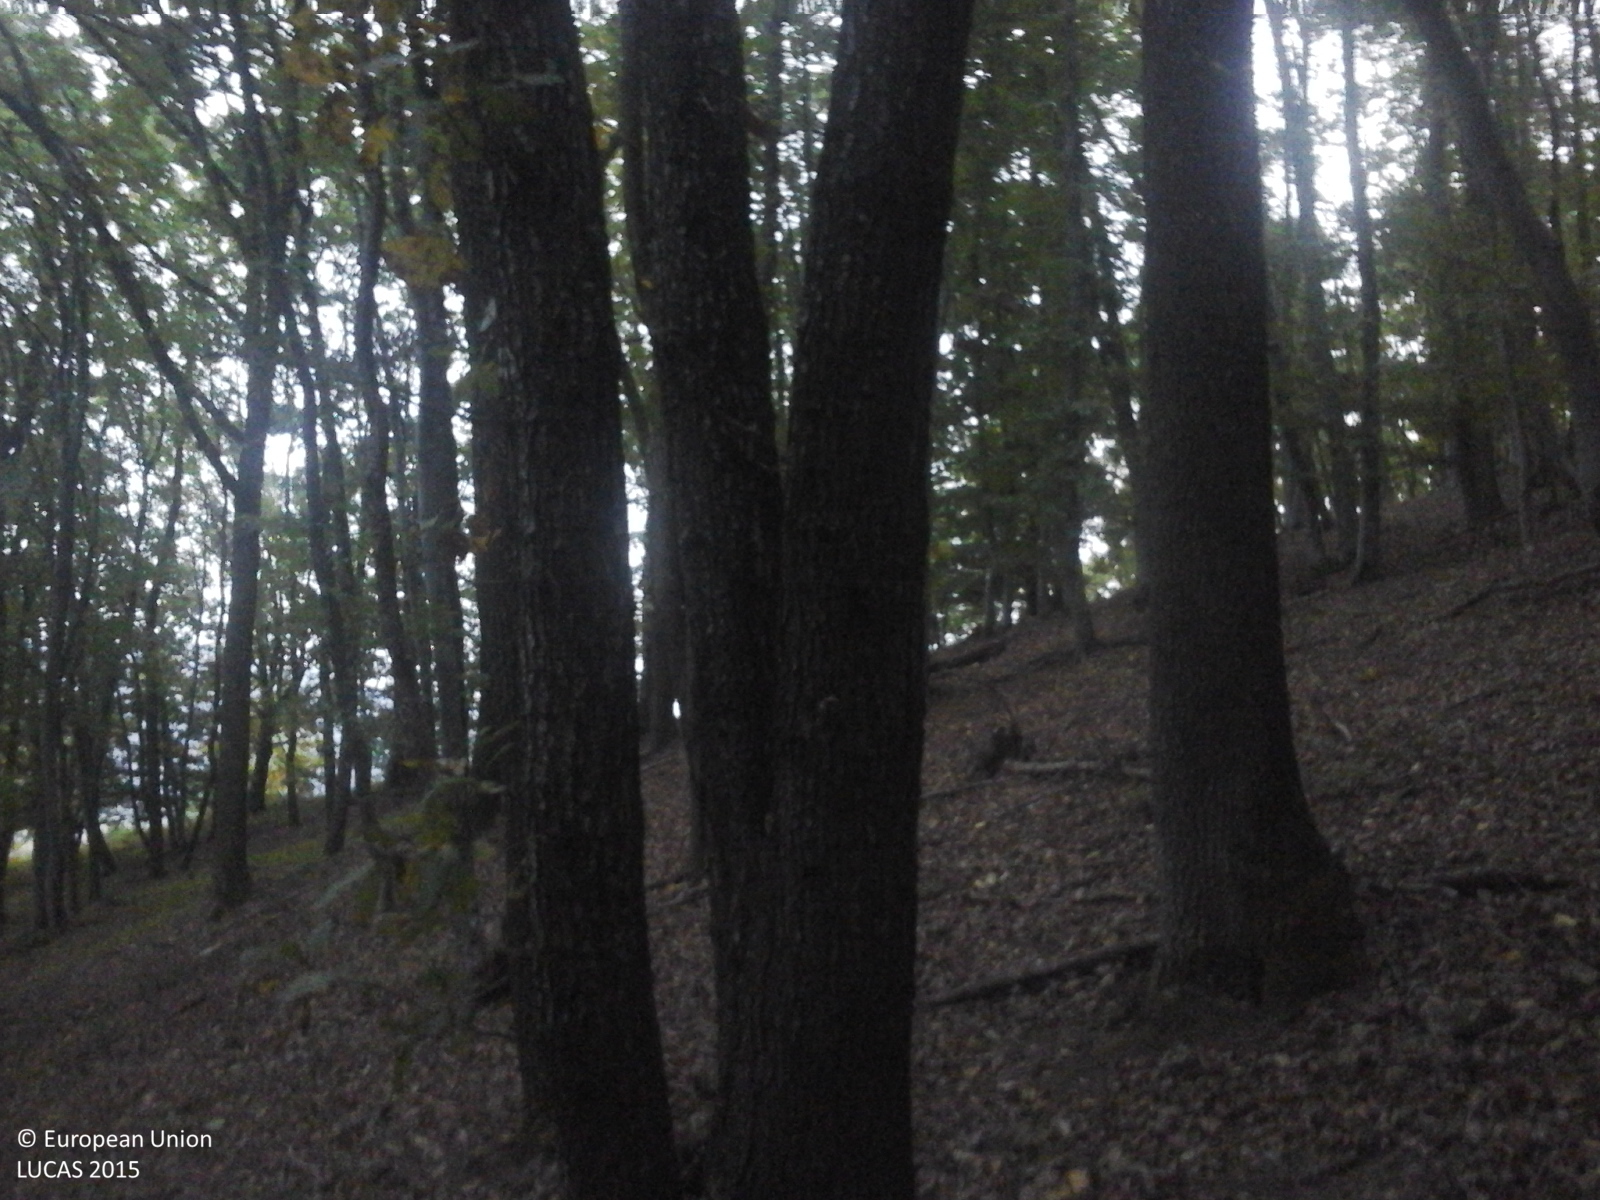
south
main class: Woodland
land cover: Broadleaved woodland
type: beech forest
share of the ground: > 75 %
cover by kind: broadleaved forest trees 100 %
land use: Forestry
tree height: > 5 m
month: October
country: RO
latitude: 46.3800
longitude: 24.7705
